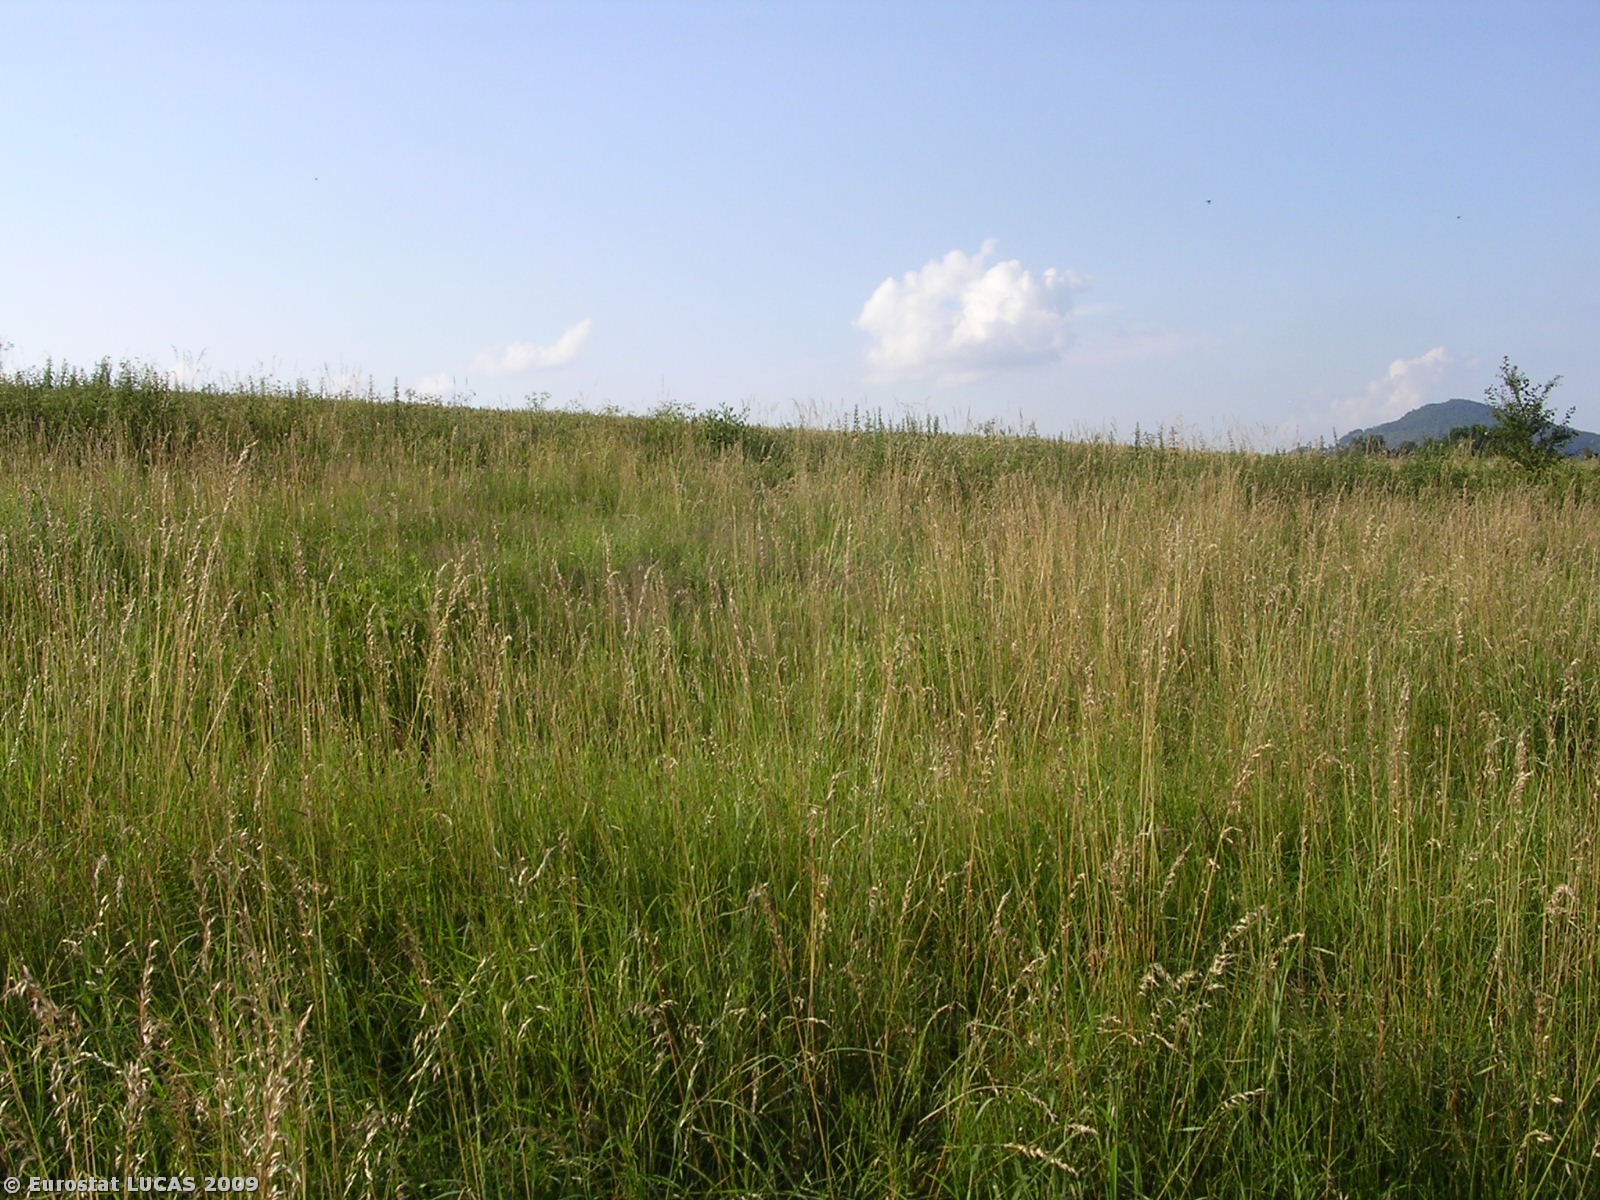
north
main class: Grassland
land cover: Grassland without tree/shrub cover
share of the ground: > 75 %
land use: Agriculture (excluding fallow land and kitchen gardens)
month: July
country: CZ
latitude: 50.6812
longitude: 14.7151
